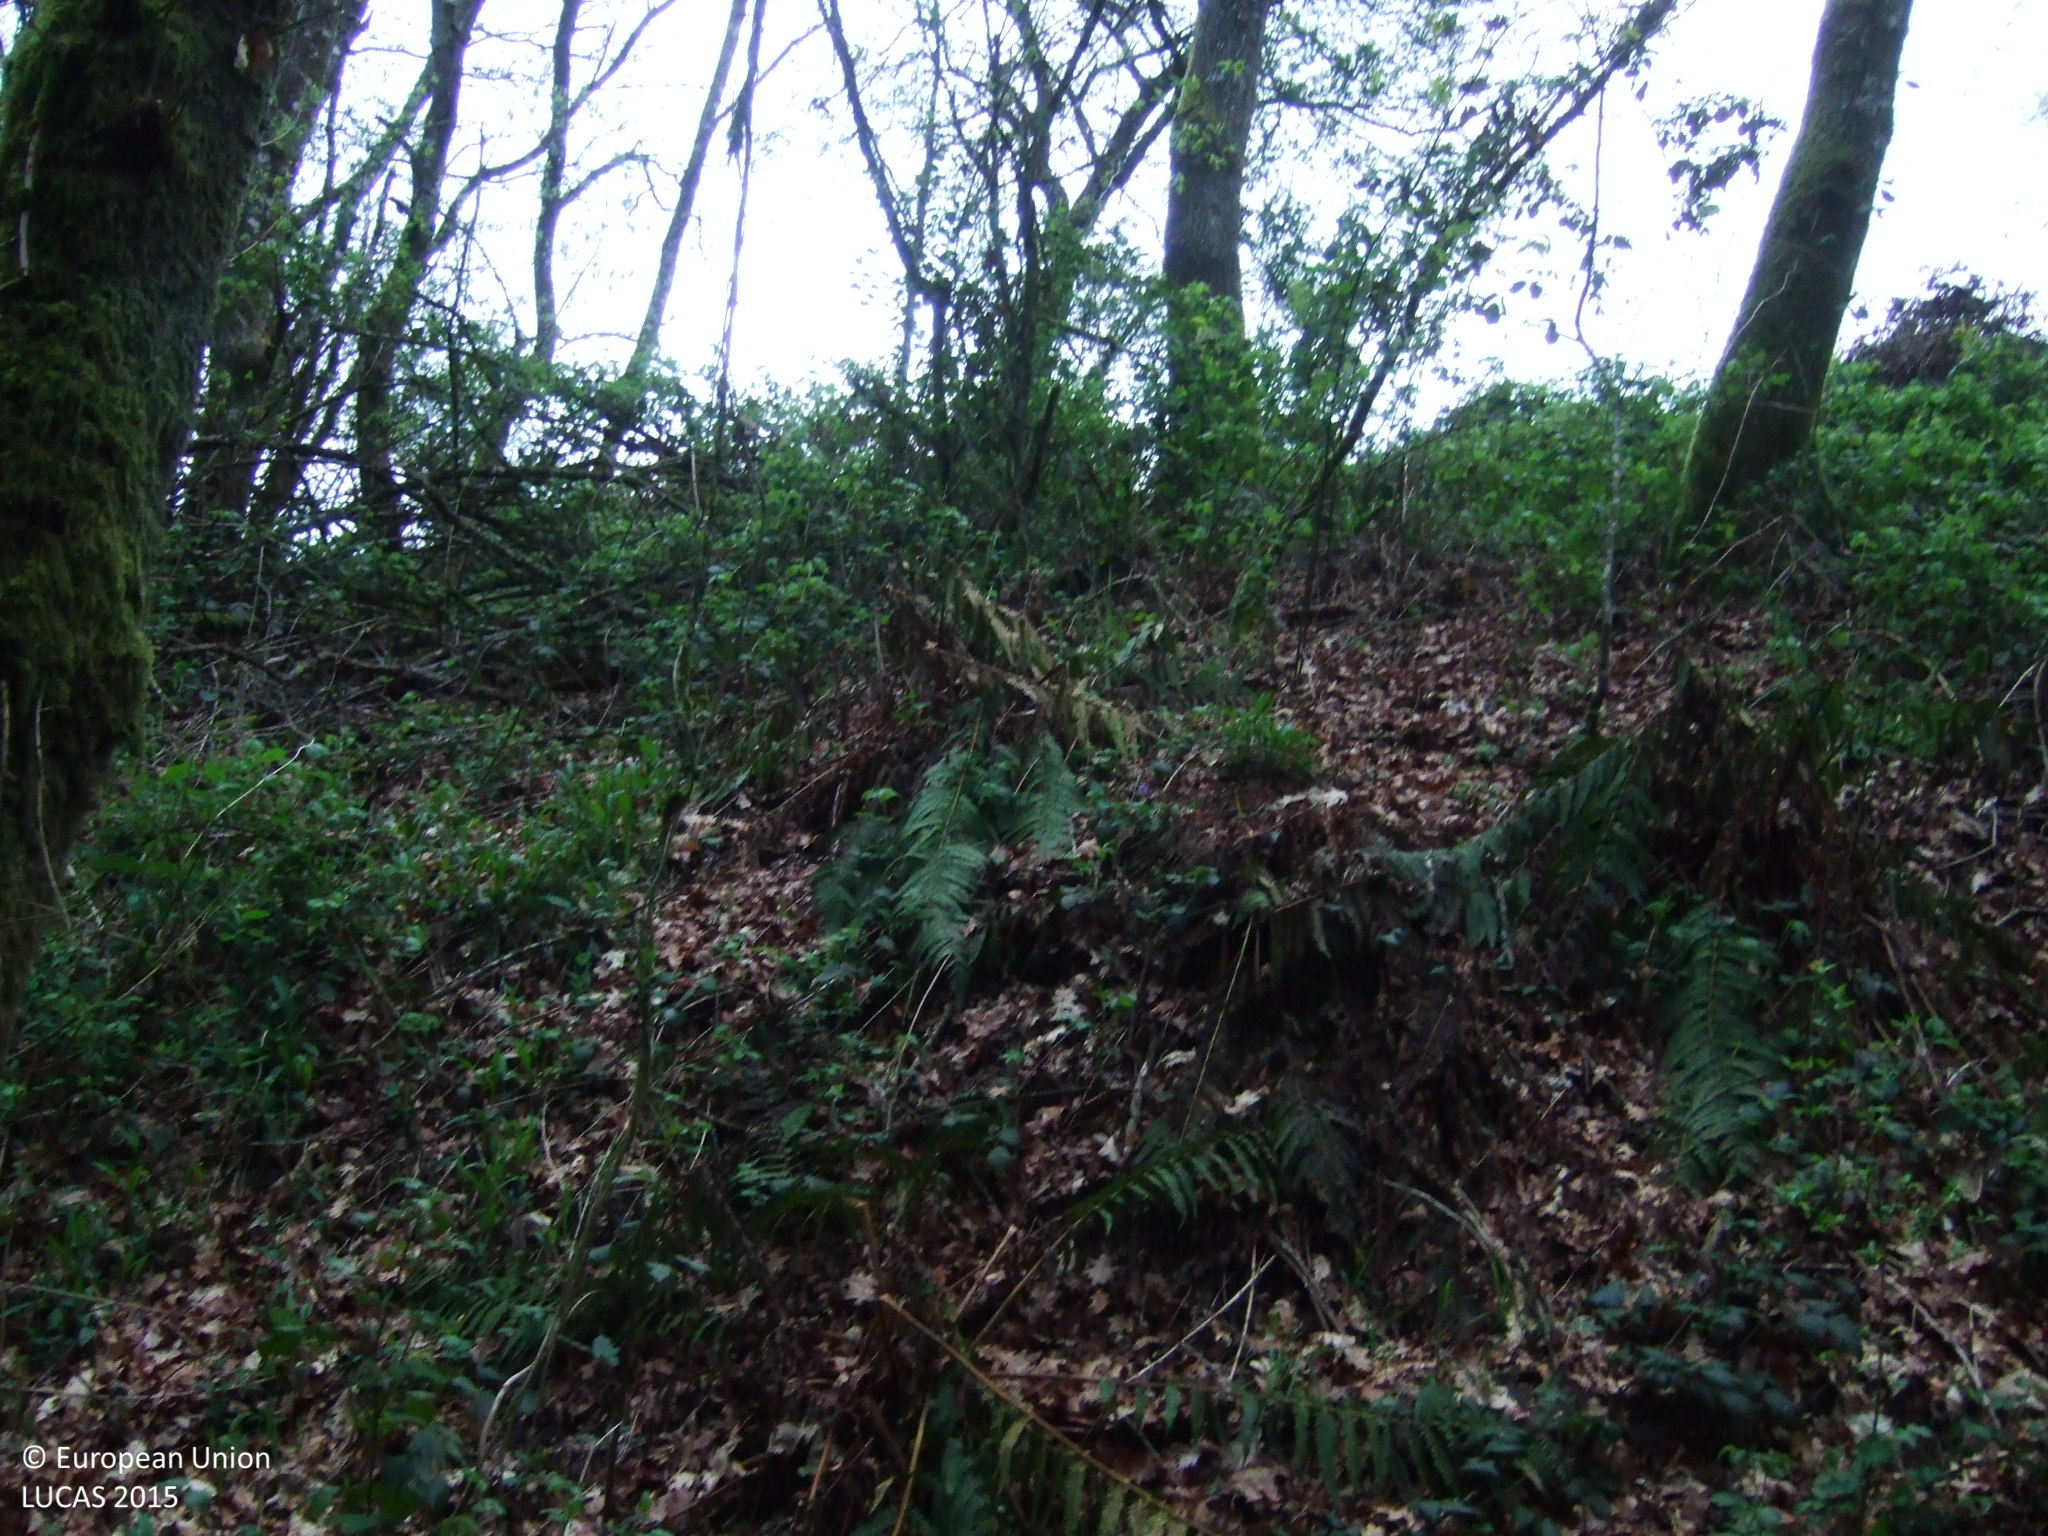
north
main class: Woodland
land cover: Broadleaved woodland
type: floodplain forest
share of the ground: > 75 %
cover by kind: broadleaved forest trees 90 %, shrubs 10 %
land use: Forestry
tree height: > 5 m
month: April
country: ES
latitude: 42.9481
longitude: -7.5666
